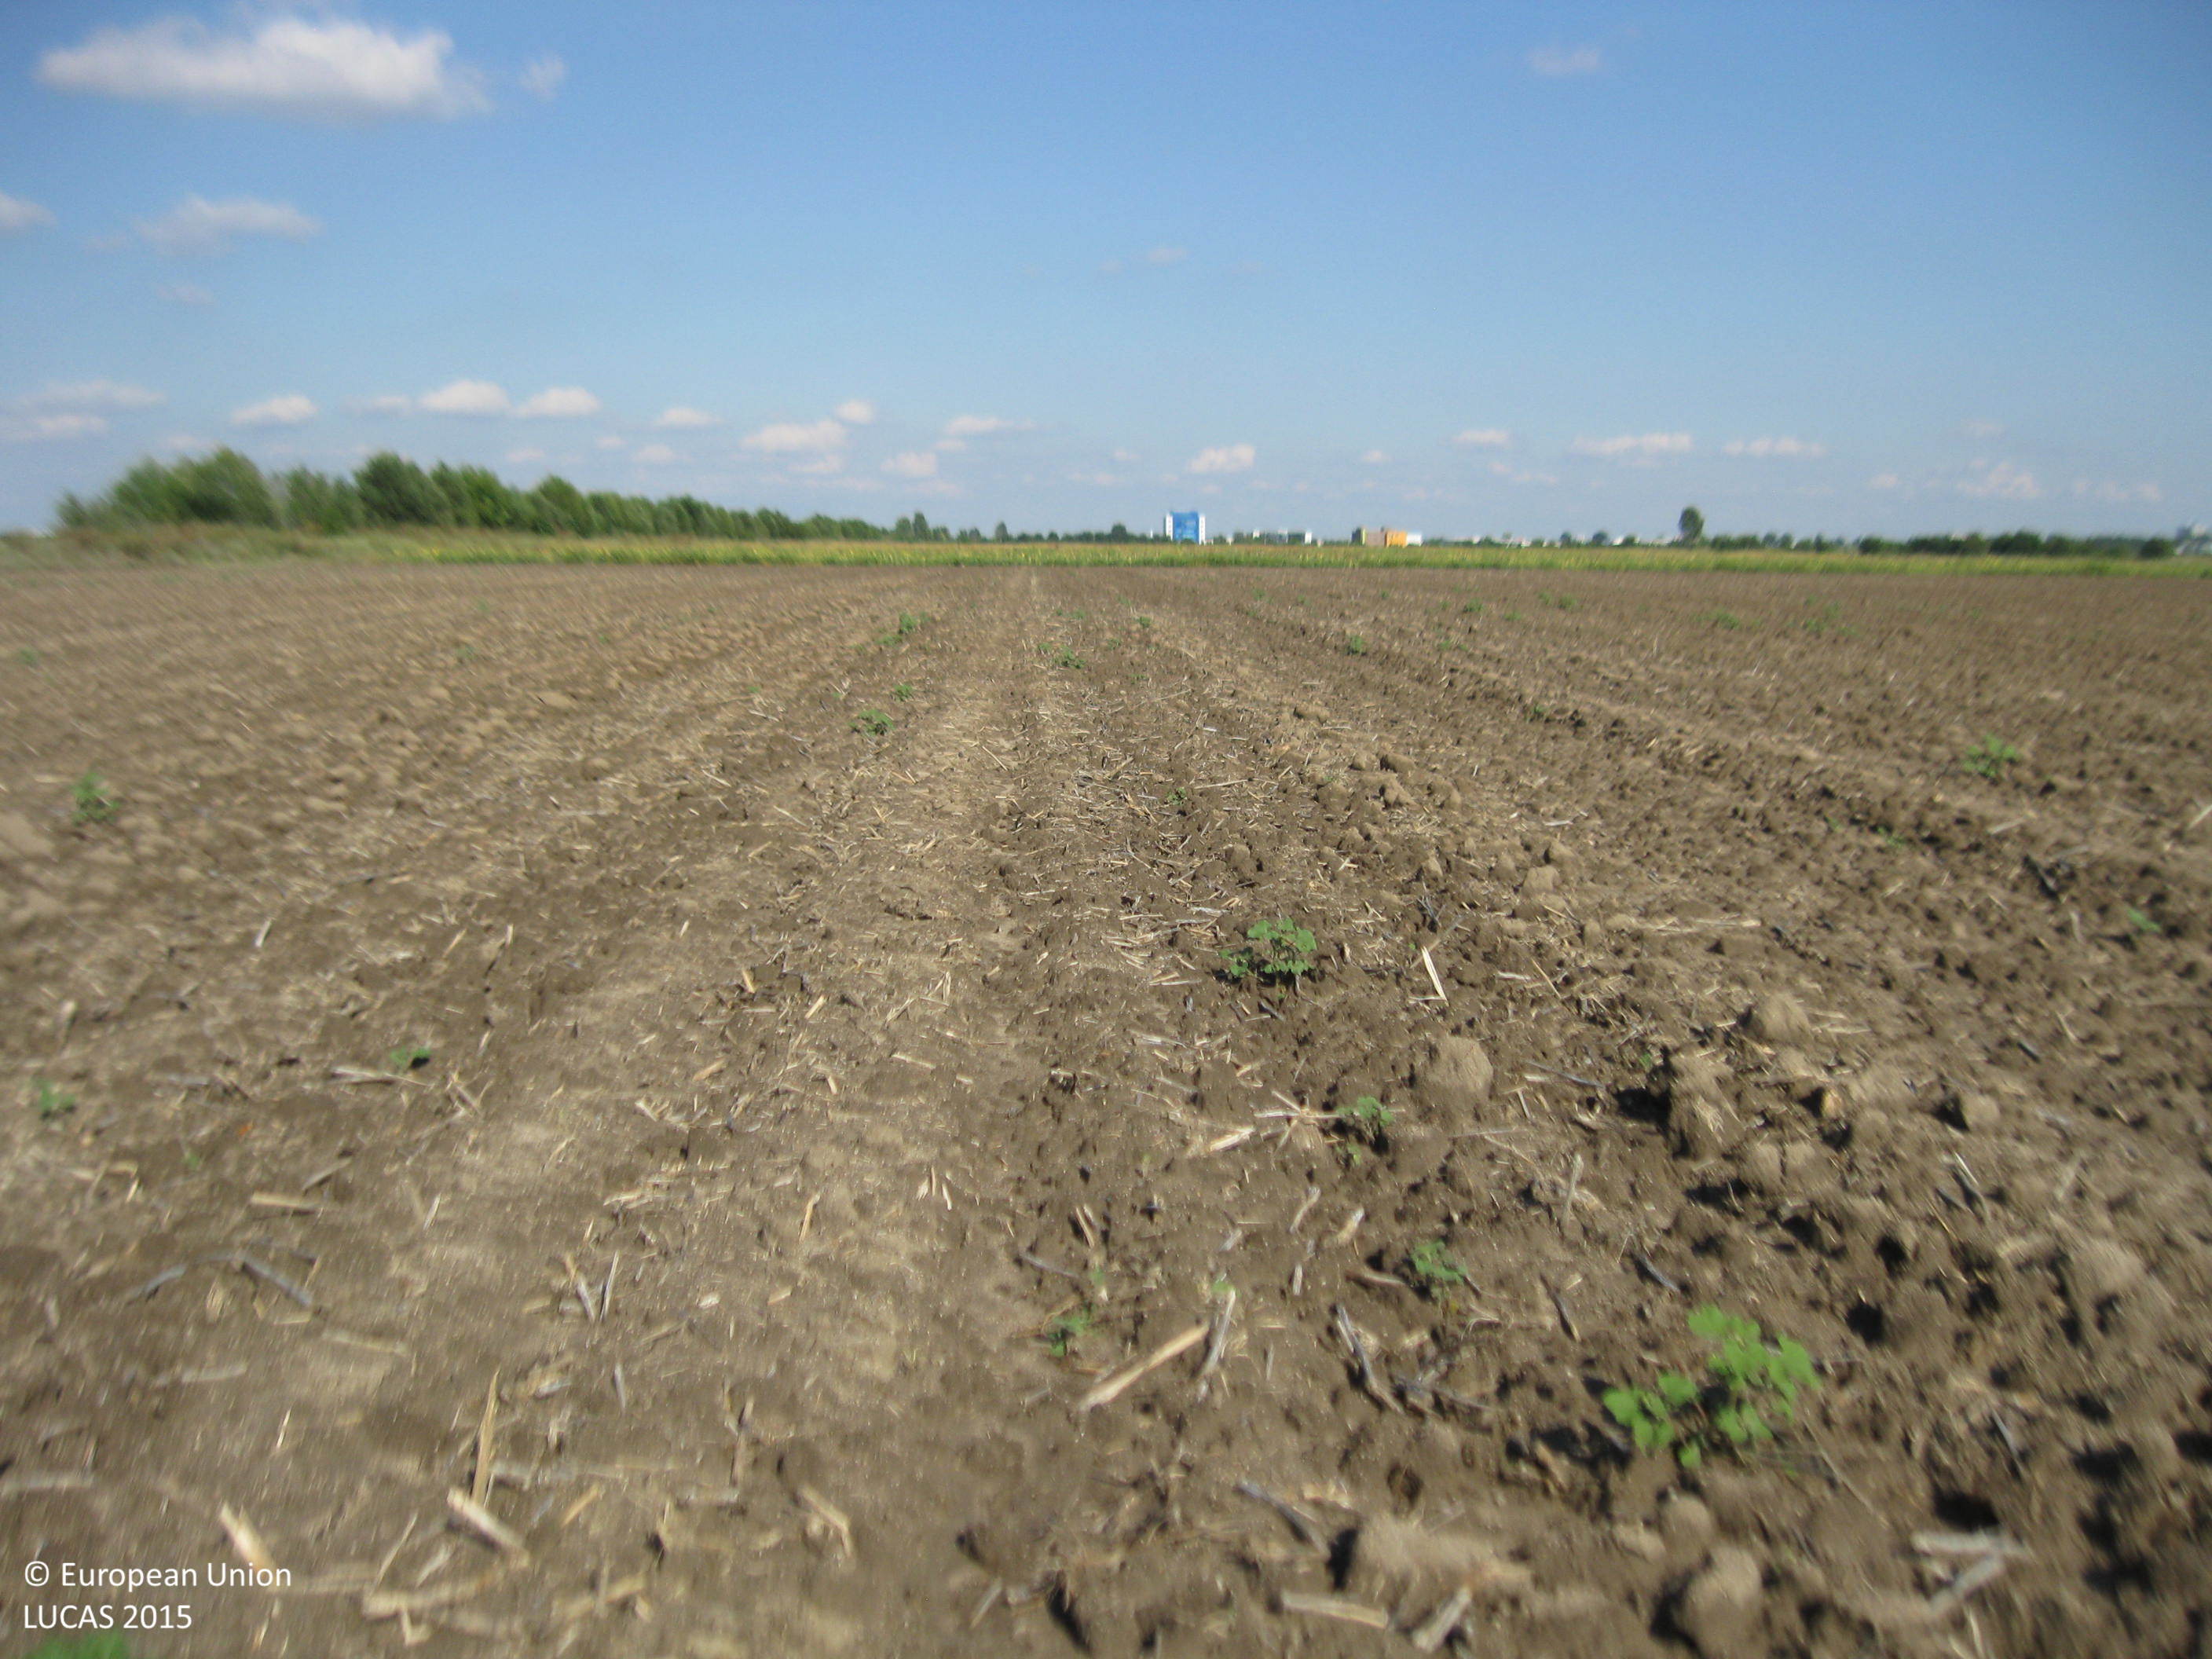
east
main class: Cropland
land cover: Sunflower
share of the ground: < 10 %
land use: Agriculture (excluding fallow land and kitchen gardens)
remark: Tilled/Sowed
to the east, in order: Sunflower; Grass margins; Sunflower
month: August
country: BG
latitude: 42.1954
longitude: 24.7166
